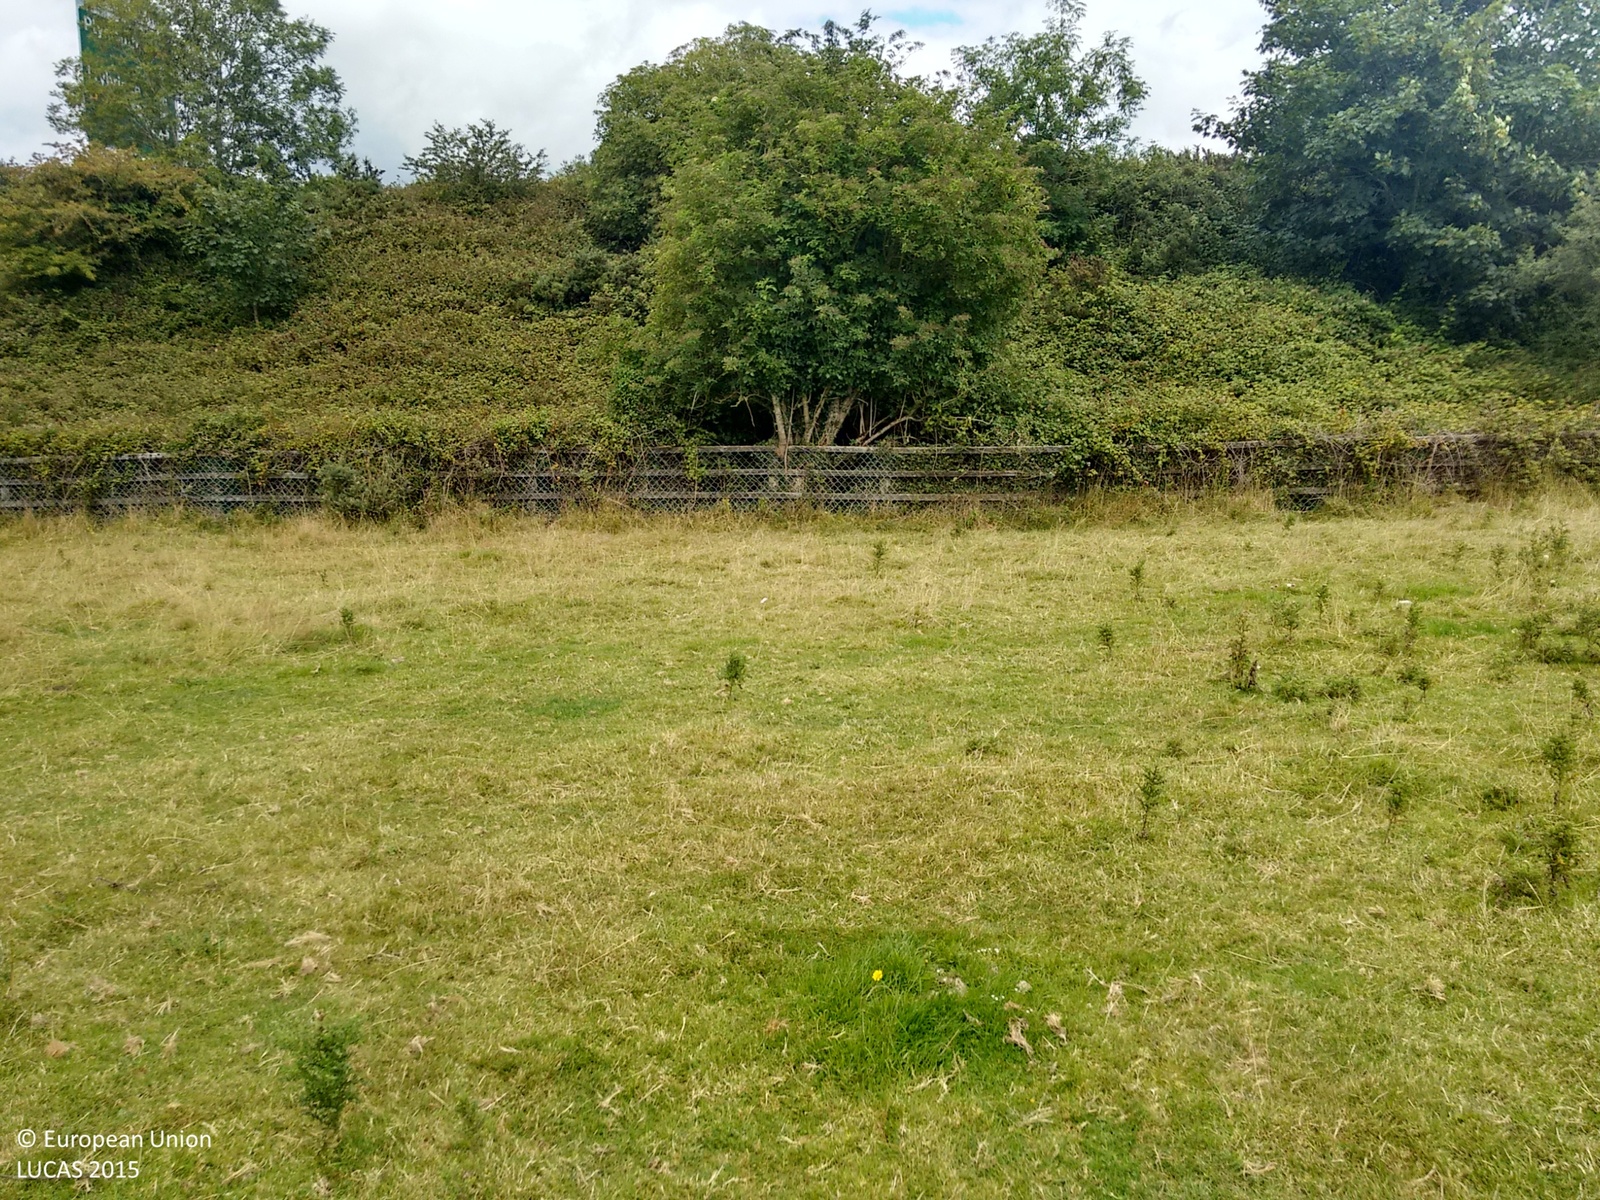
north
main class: Grassland
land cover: Grassland without tree/shrub cover
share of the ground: > 75 %
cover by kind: herbaceous plants 100 %
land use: Agriculture (excluding fallow land and kitchen gardens)
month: August
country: GB
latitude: 50.3841
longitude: -3.9165
